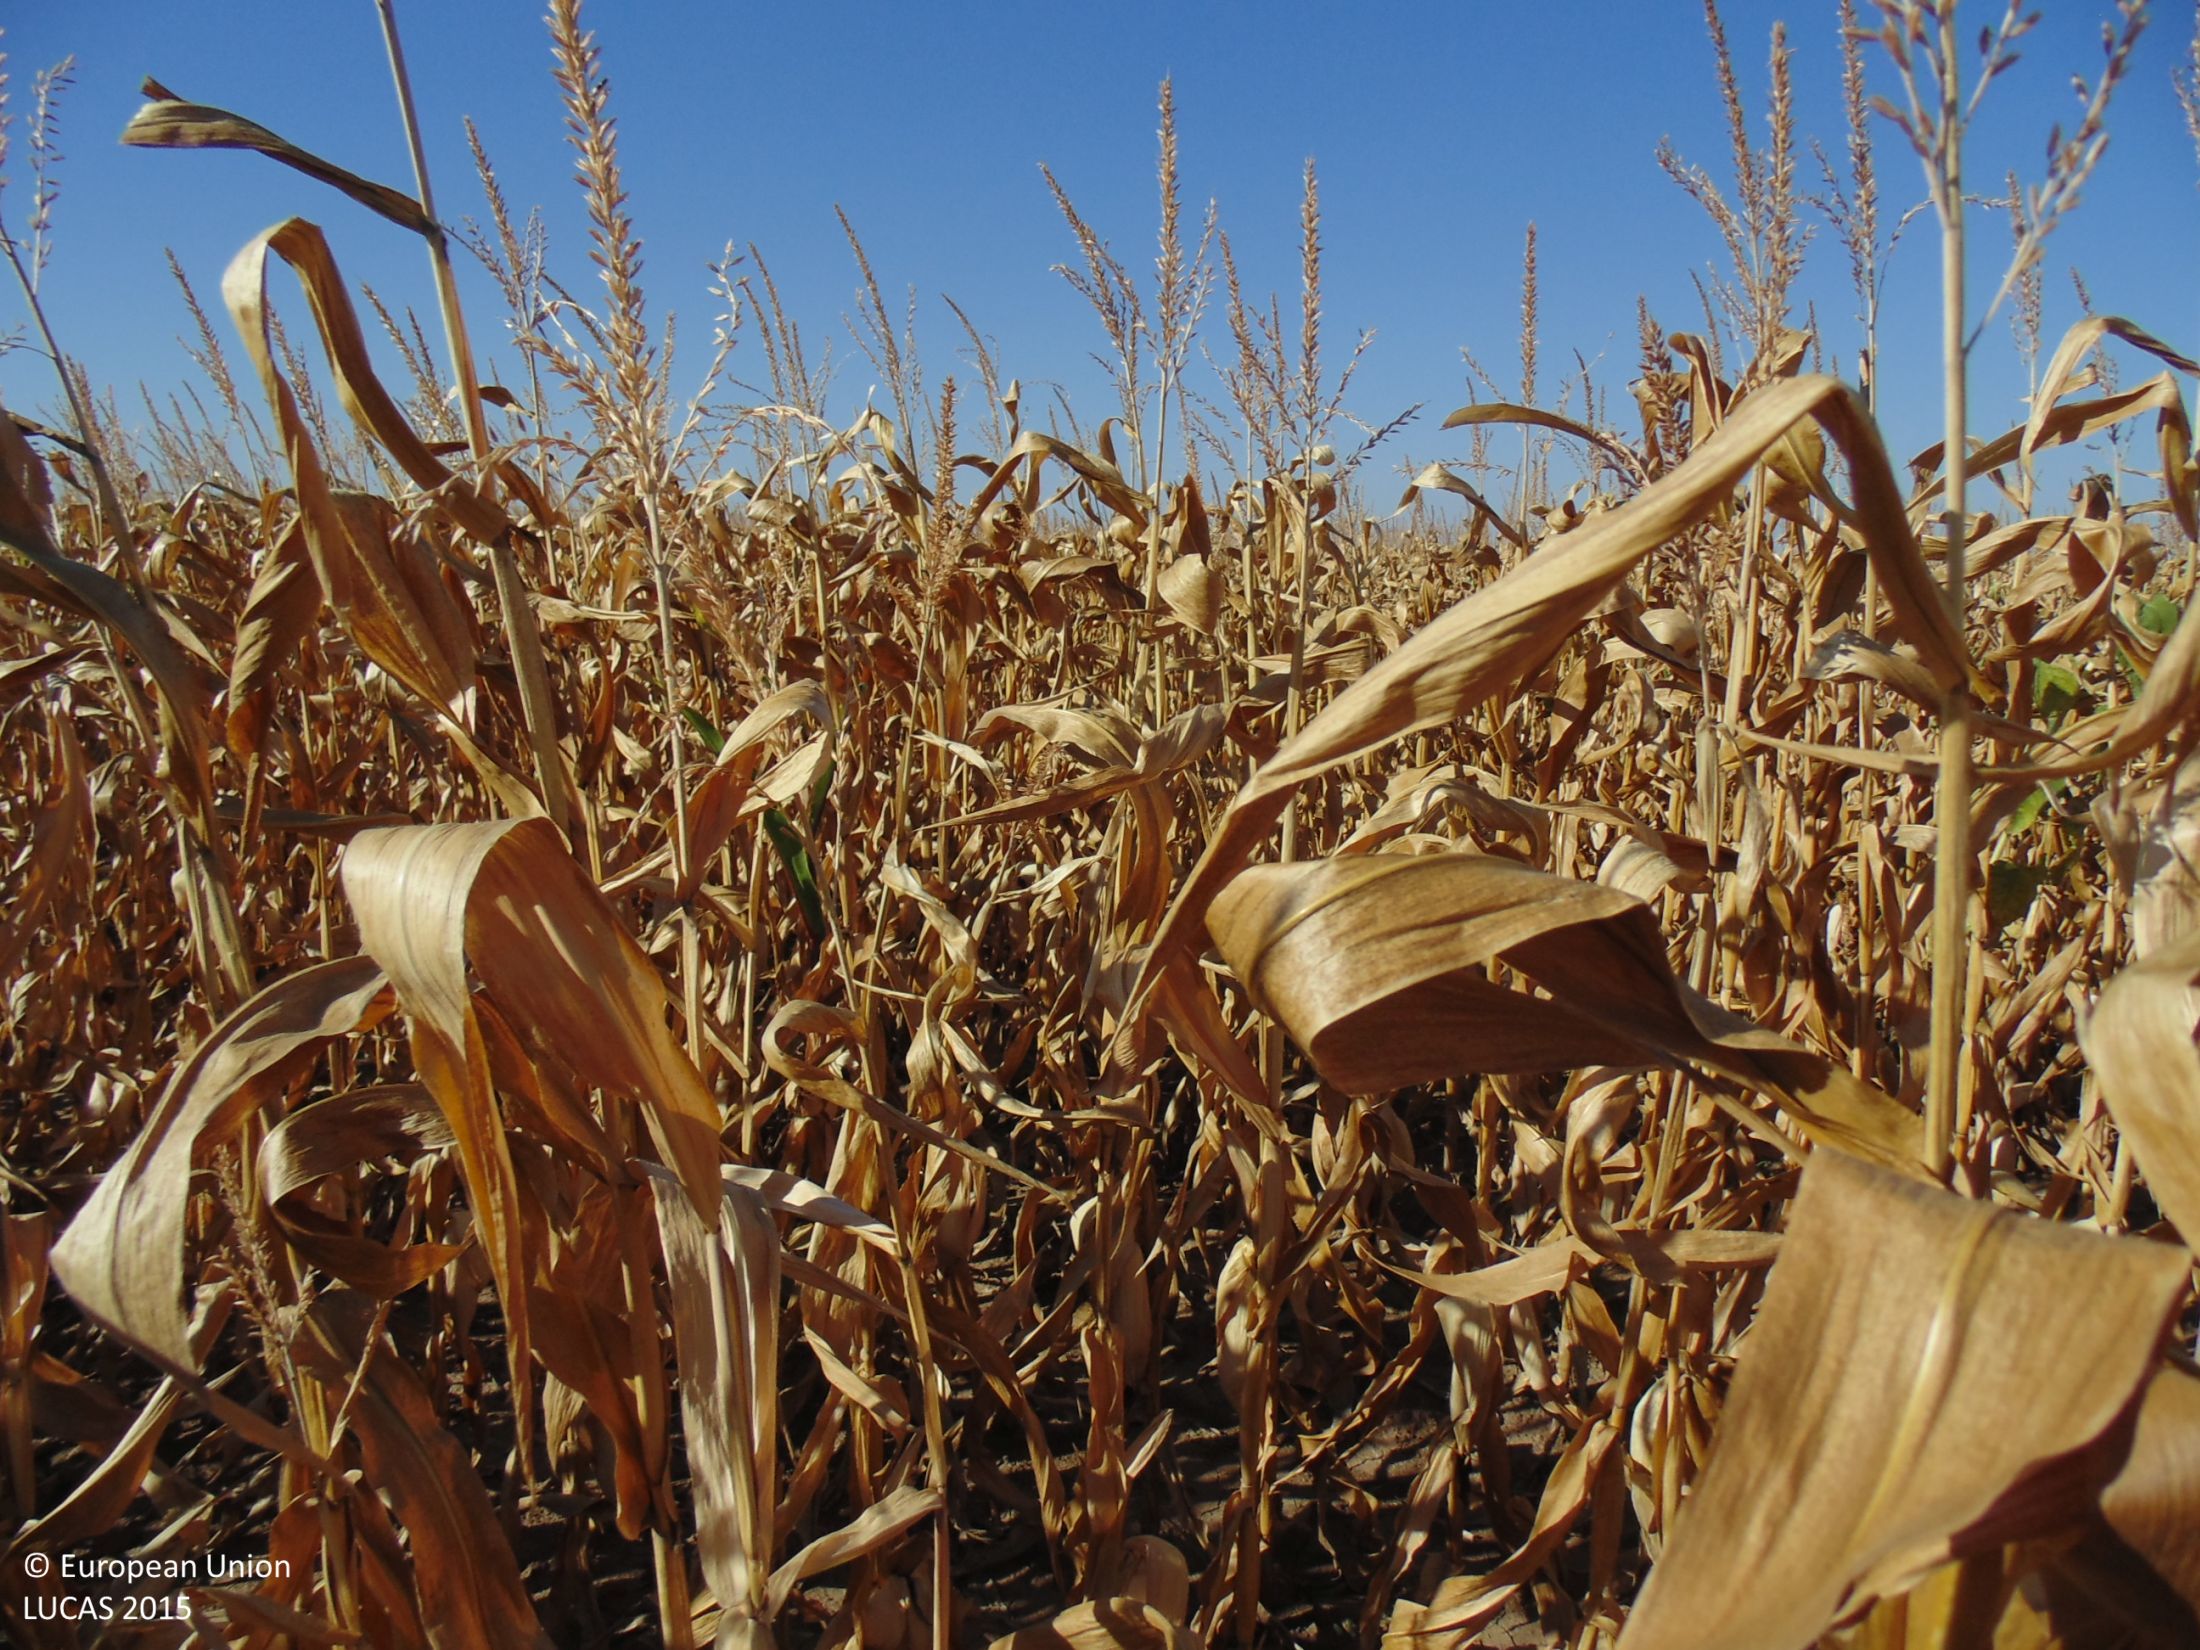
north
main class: Cropland
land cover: Maize
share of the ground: > 75 %
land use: Agriculture (excluding fallow land and kitchen gardens)
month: September
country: BG
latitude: 43.6860
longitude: 27.1313
